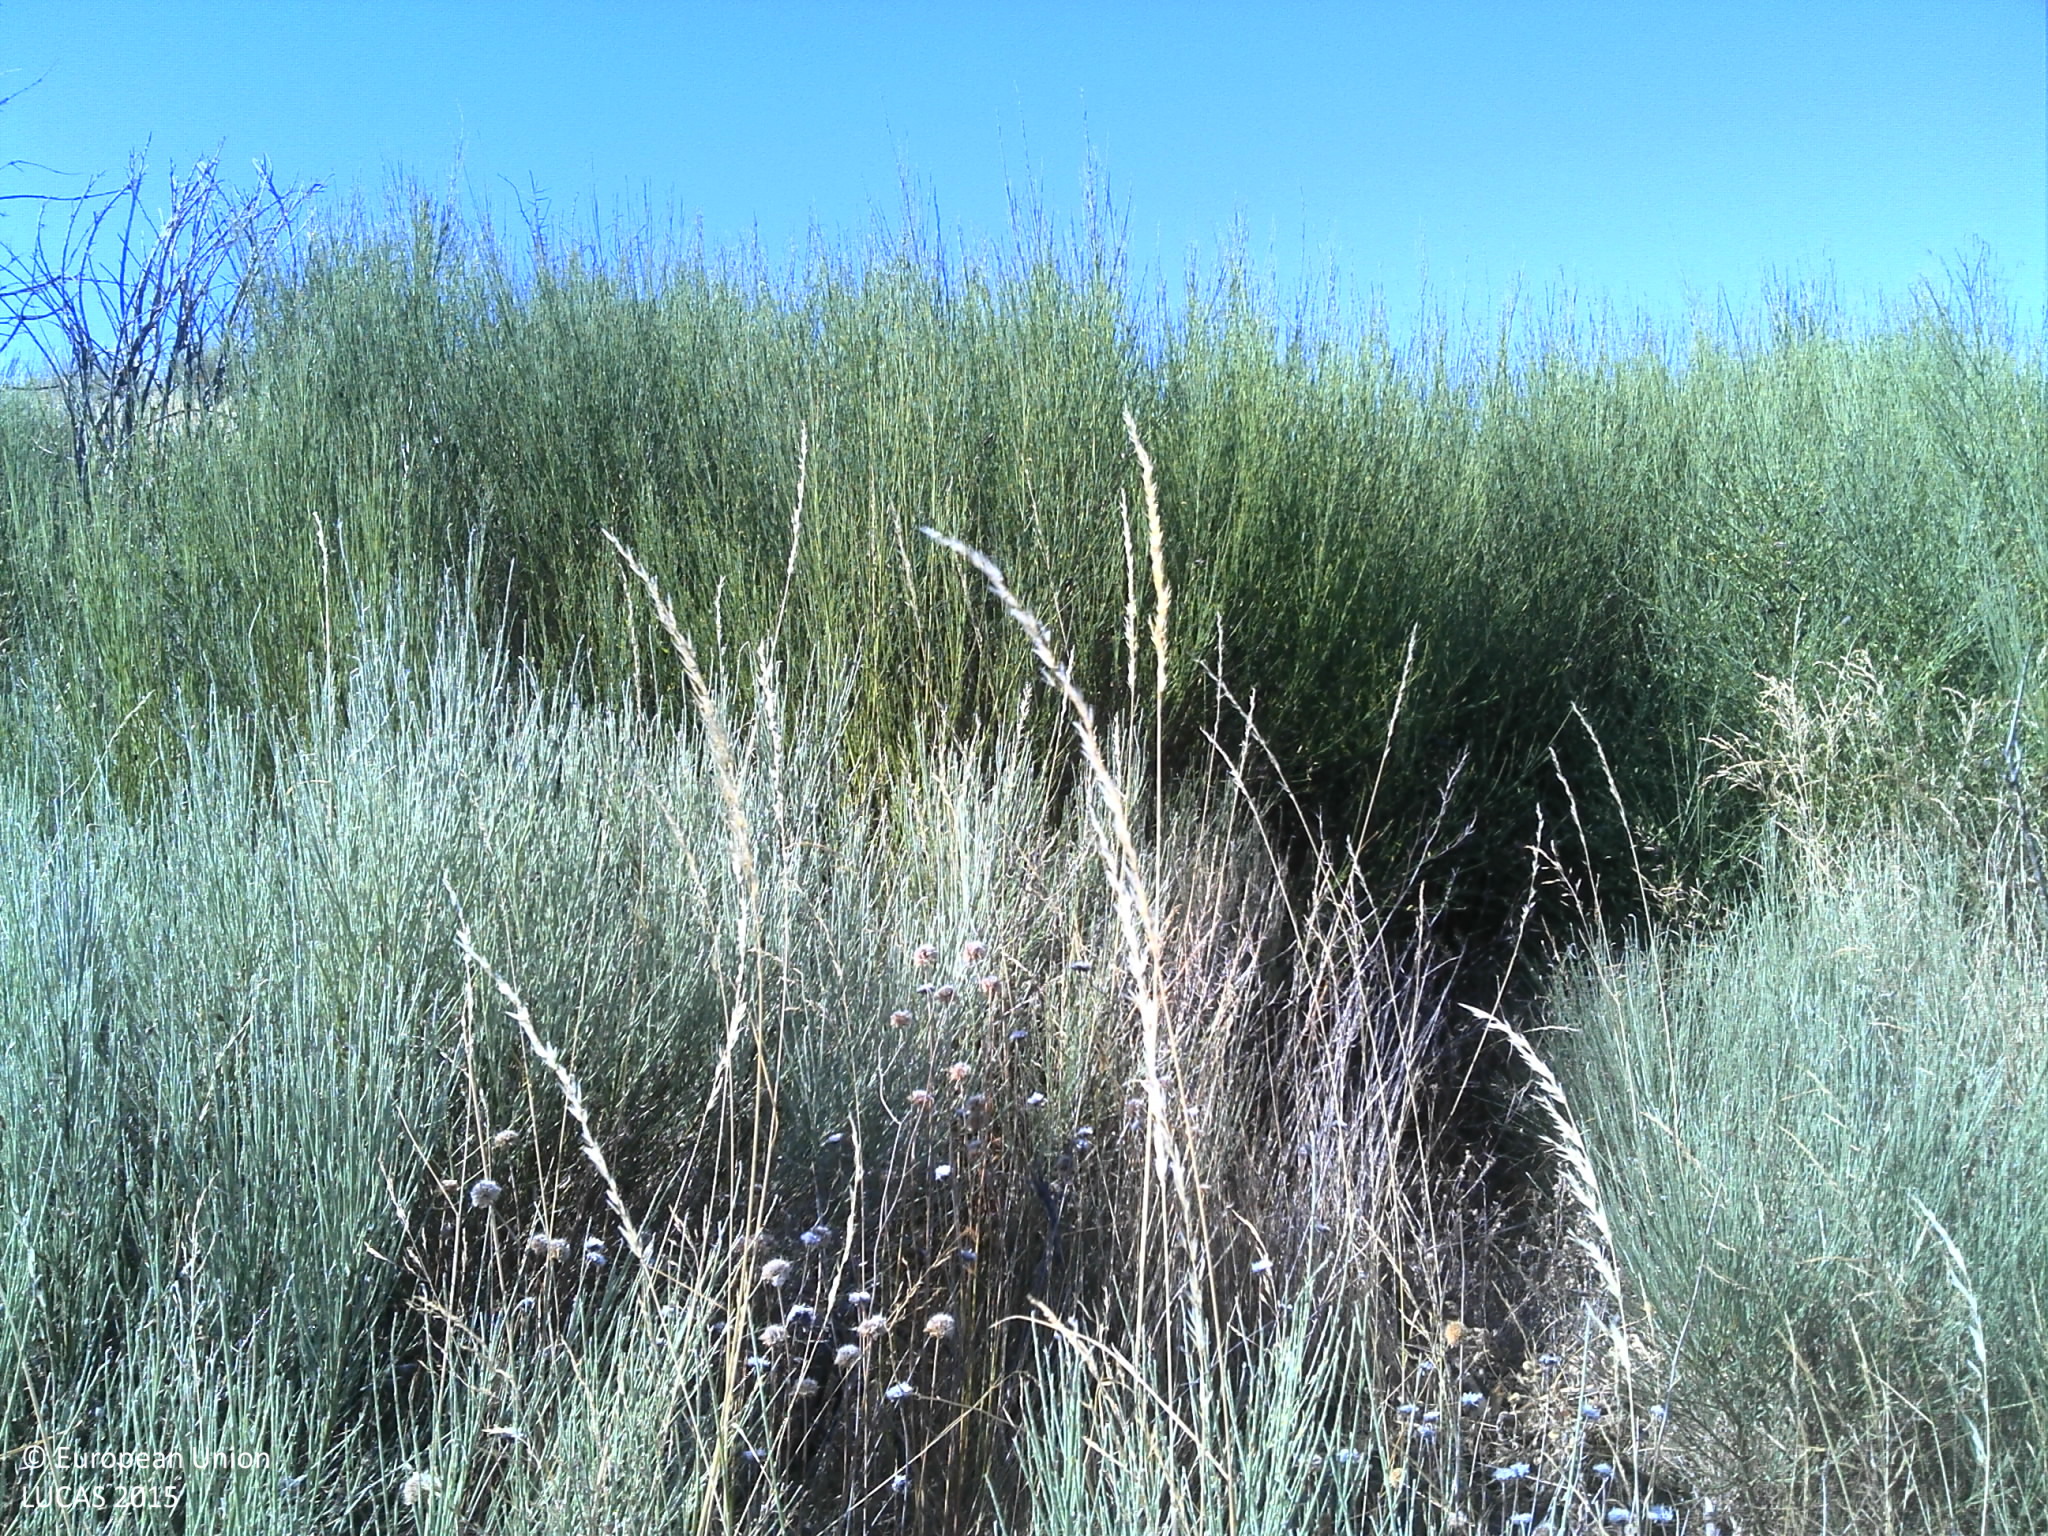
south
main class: Shrubland
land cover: Shrubland without tree cover
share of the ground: > 75 %
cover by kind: shrubs 95 %, herbaceous plants 5 %
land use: Abandoned areas
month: July
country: PT
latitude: 41.4436
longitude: -7.0021
